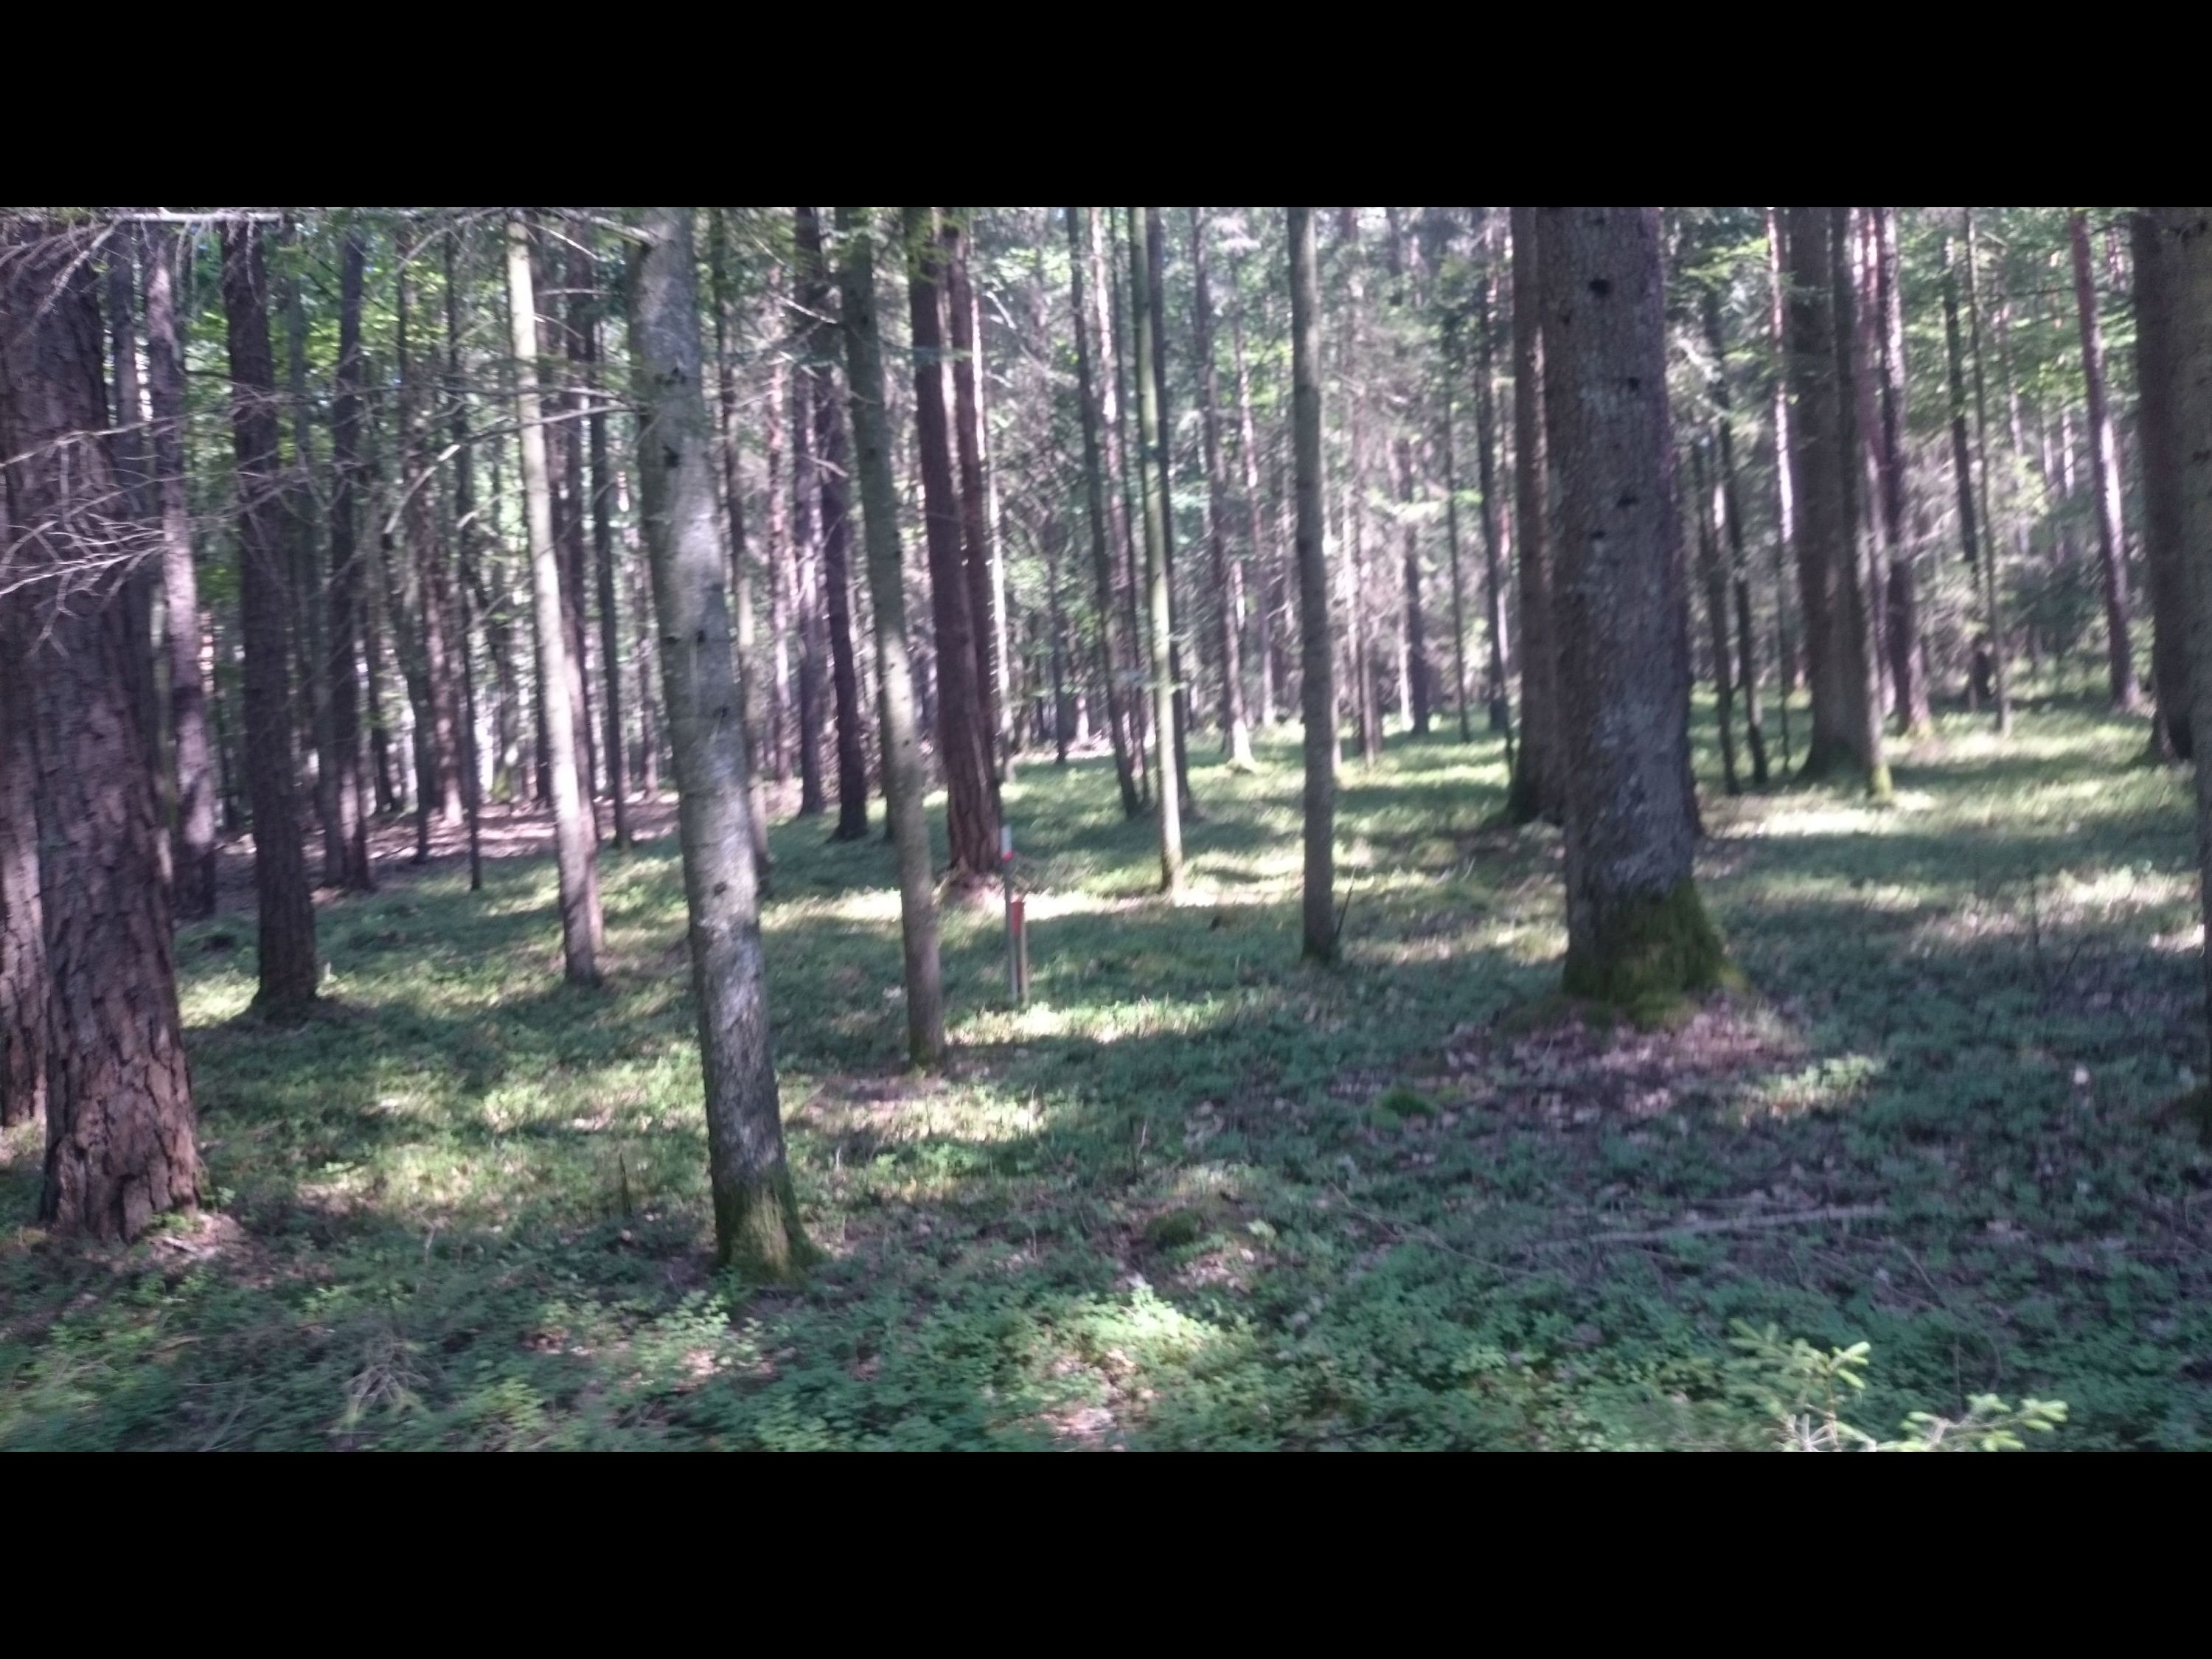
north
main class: Woodland
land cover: Pine dominated coniferous woodland
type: hemiboreal forest and nemoral coniferous forest and mixed broadleaved-coniferous forest
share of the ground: > 75 %
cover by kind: coniferous forest trees 80 %, shrubs 10 %, herbaceous plants 10 %
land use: Forestry
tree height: > 5 m
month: July
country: AT
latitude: 47.1232
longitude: 15.9724
